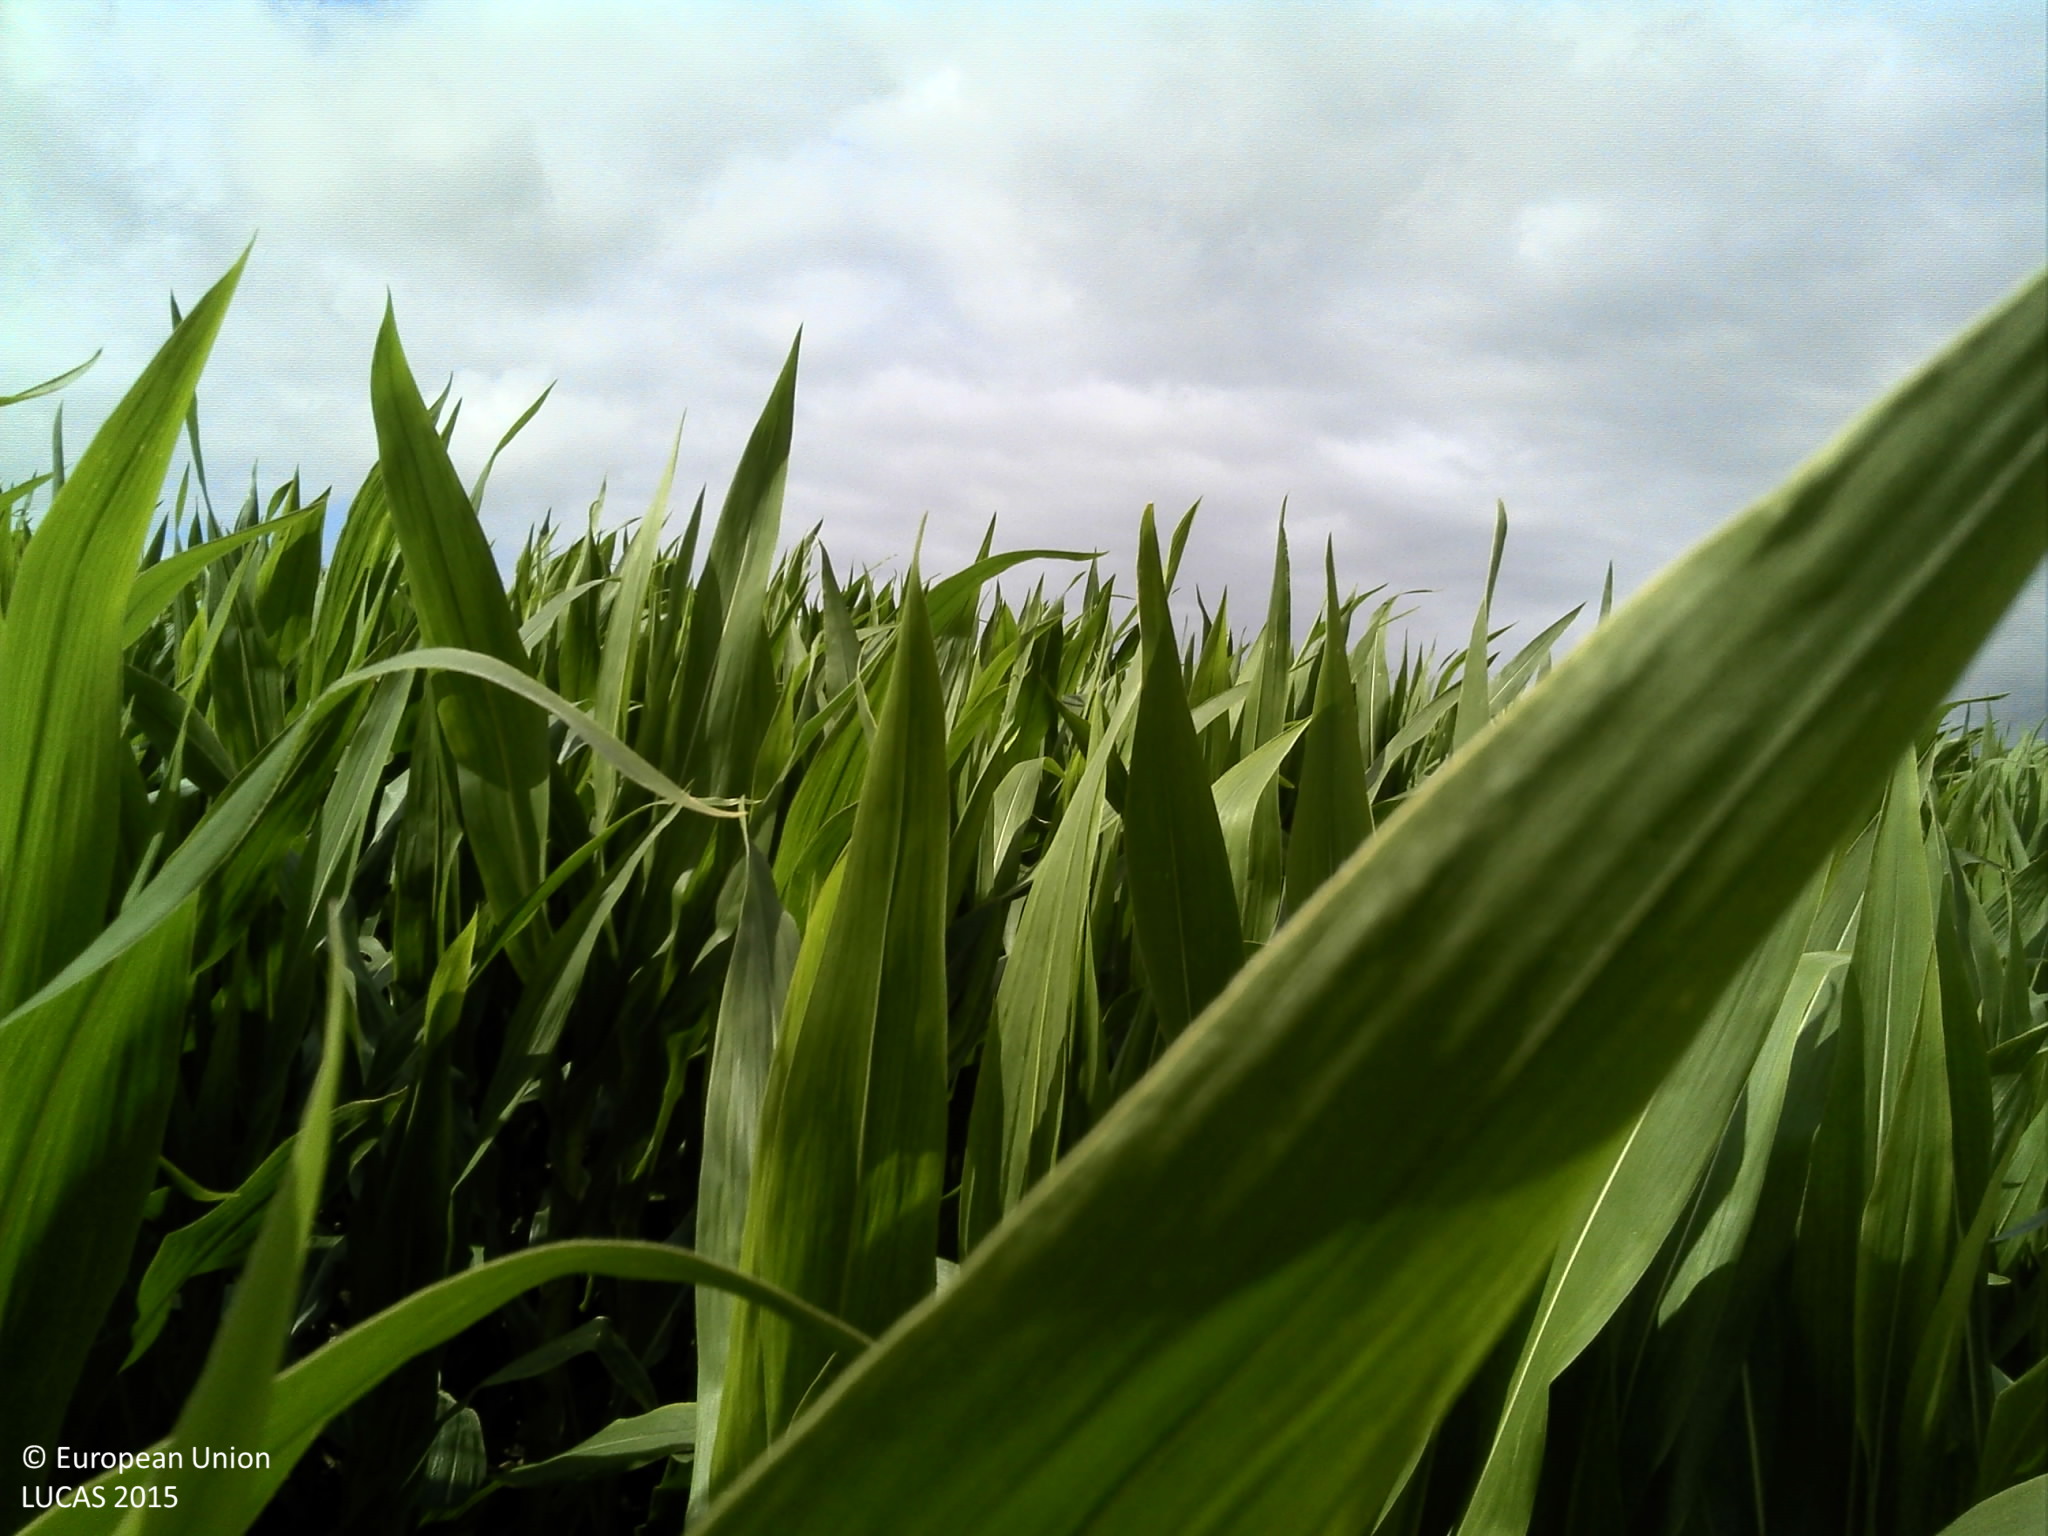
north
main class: Cropland
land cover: Maize
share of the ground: > 75 %
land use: Agriculture (excluding fallow land and kitchen gardens)
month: July
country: FR
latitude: 48.2528
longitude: -4.1653
